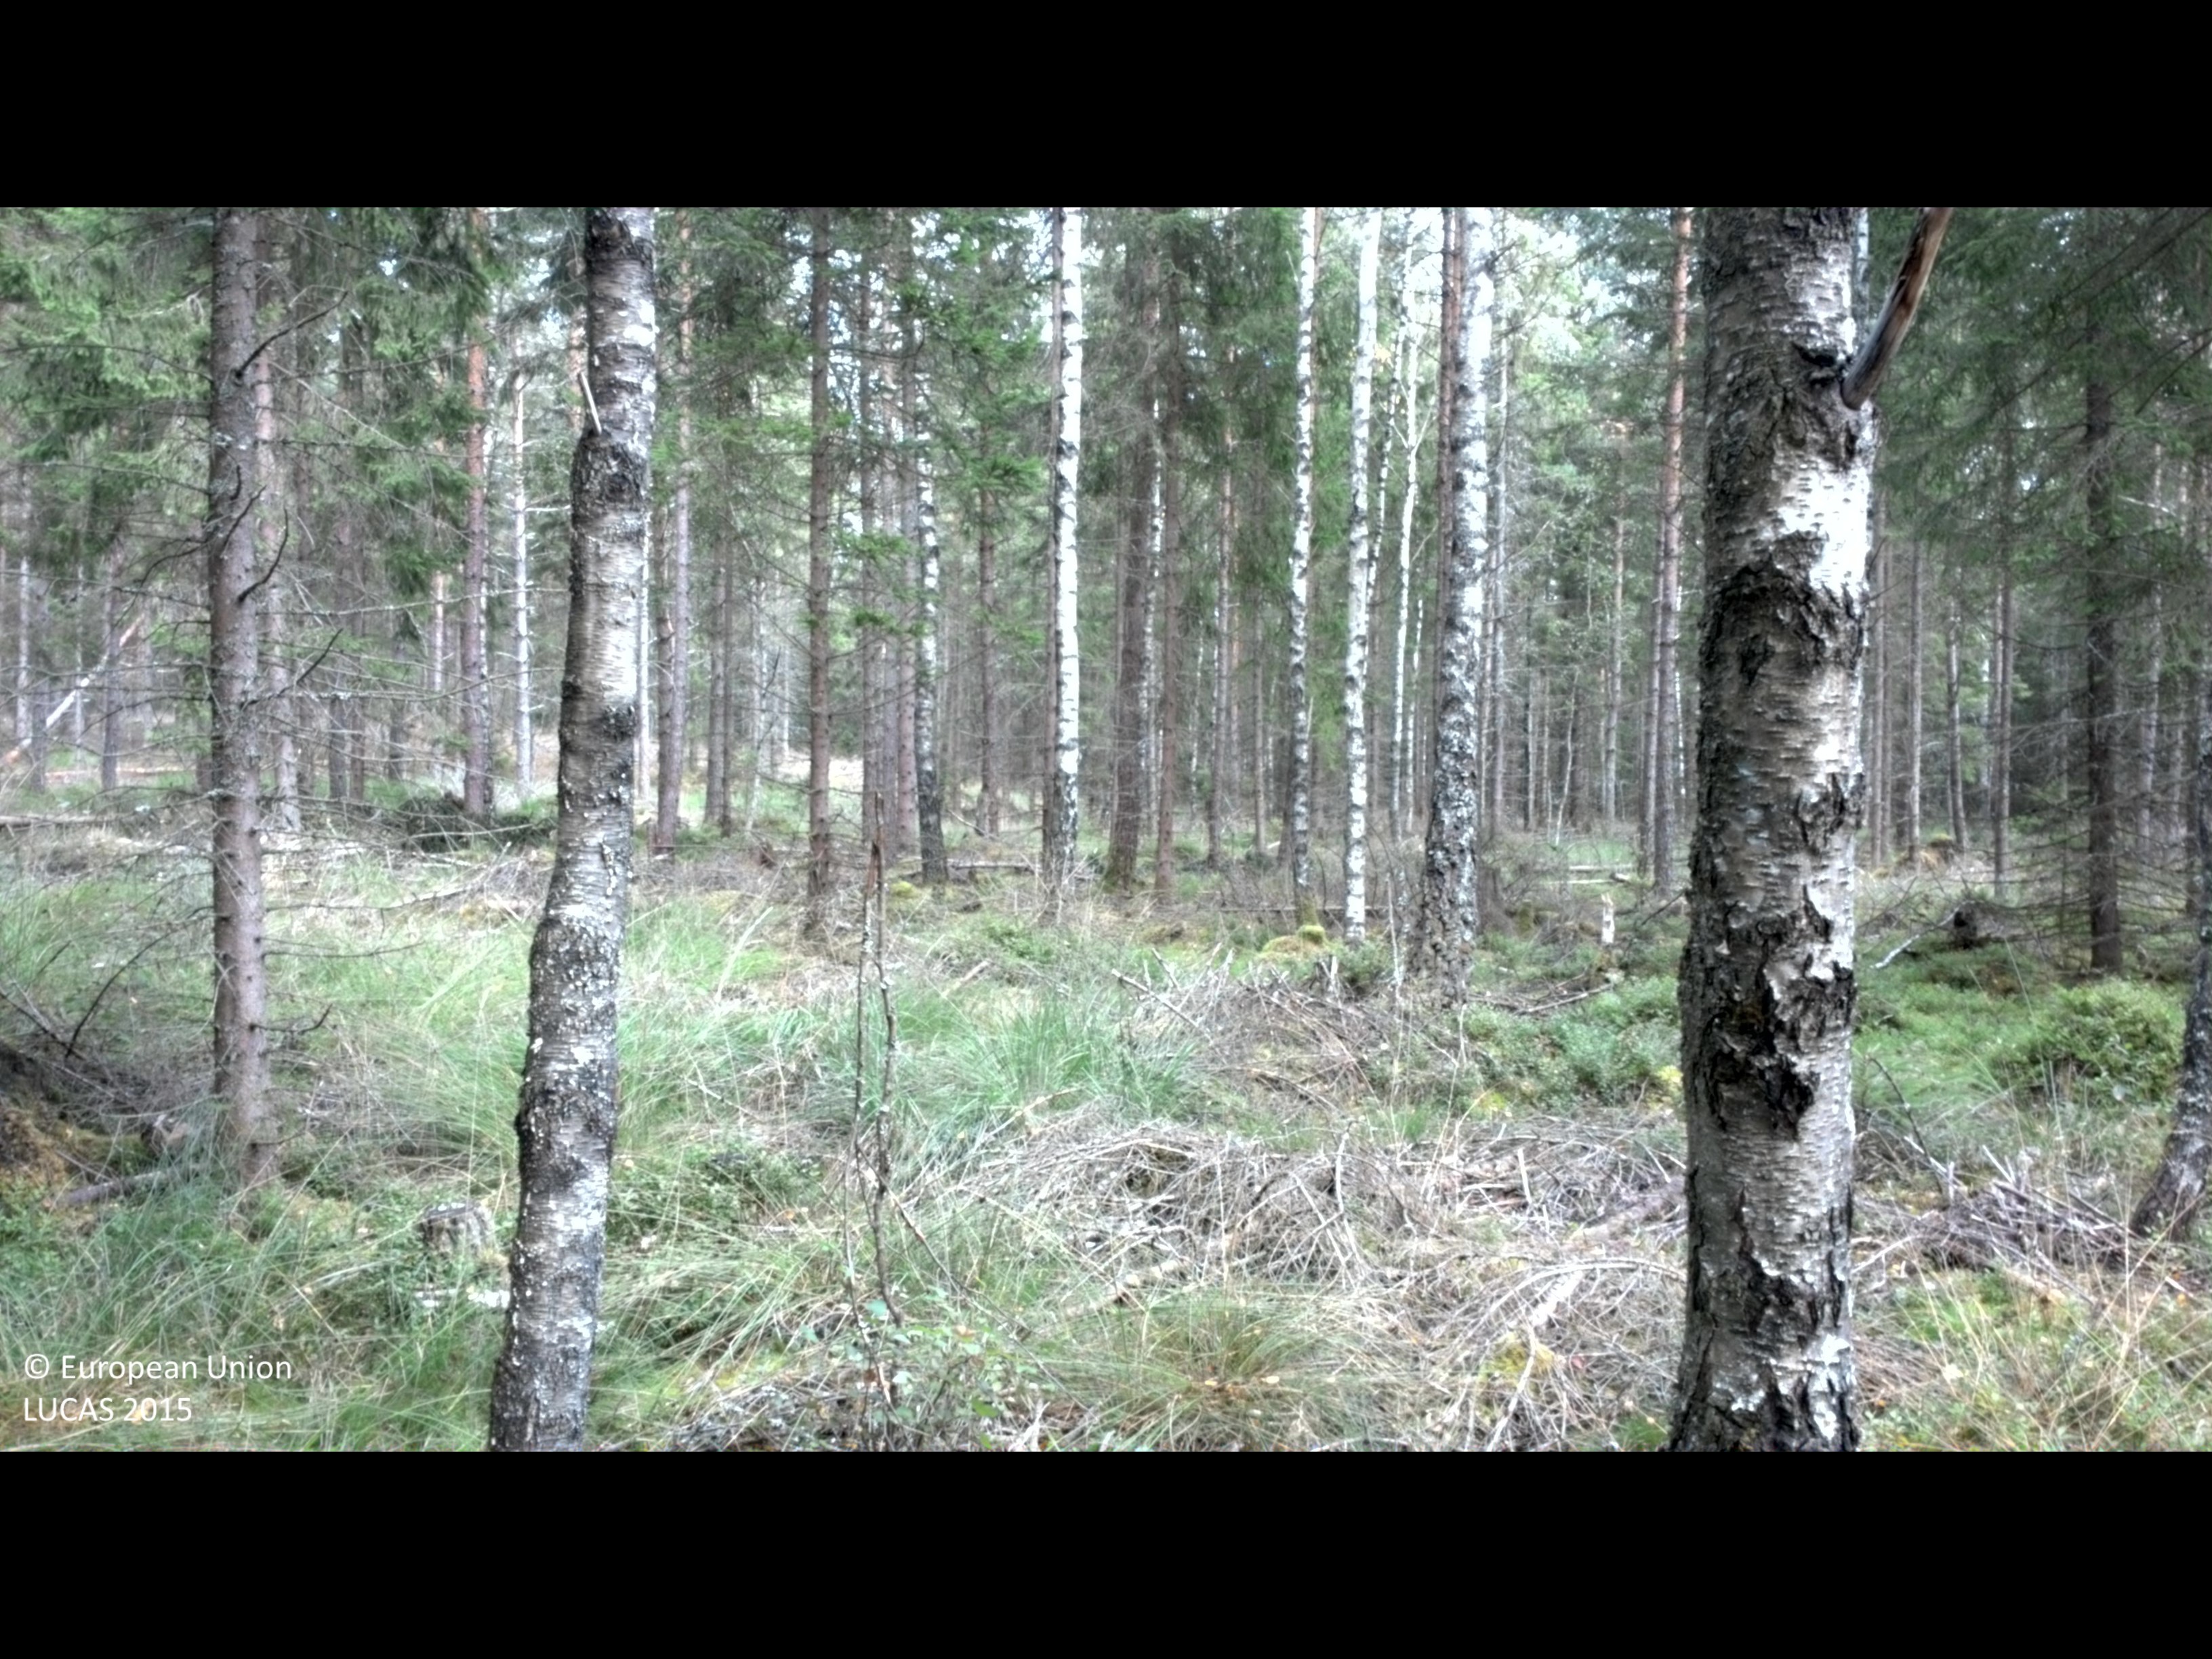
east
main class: Woodland
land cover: Spruce dominated coniferous woodland
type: boreal forest
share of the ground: 50 - 75 %
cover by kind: coniferous forest trees 60 %, shrubs 20 %, broadleaved forest trees 15 %, herbaceous plants 5 %
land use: Forestry
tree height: > 5 m
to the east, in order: Spruce dominated coniferous woodland; Tracks; Pine dominated coniferous woodland; Tracks; Spruce dominated coniferous woodland; Tracks; Spruce dominated coniferous woodland; Ditches and canals; Spruce dominated coniferous woodland; Pine dominated mixed woodland; Broadleaved woodland; Pine dominated mixed woodland
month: August
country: SE
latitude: 57.1731
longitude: 13.8828
